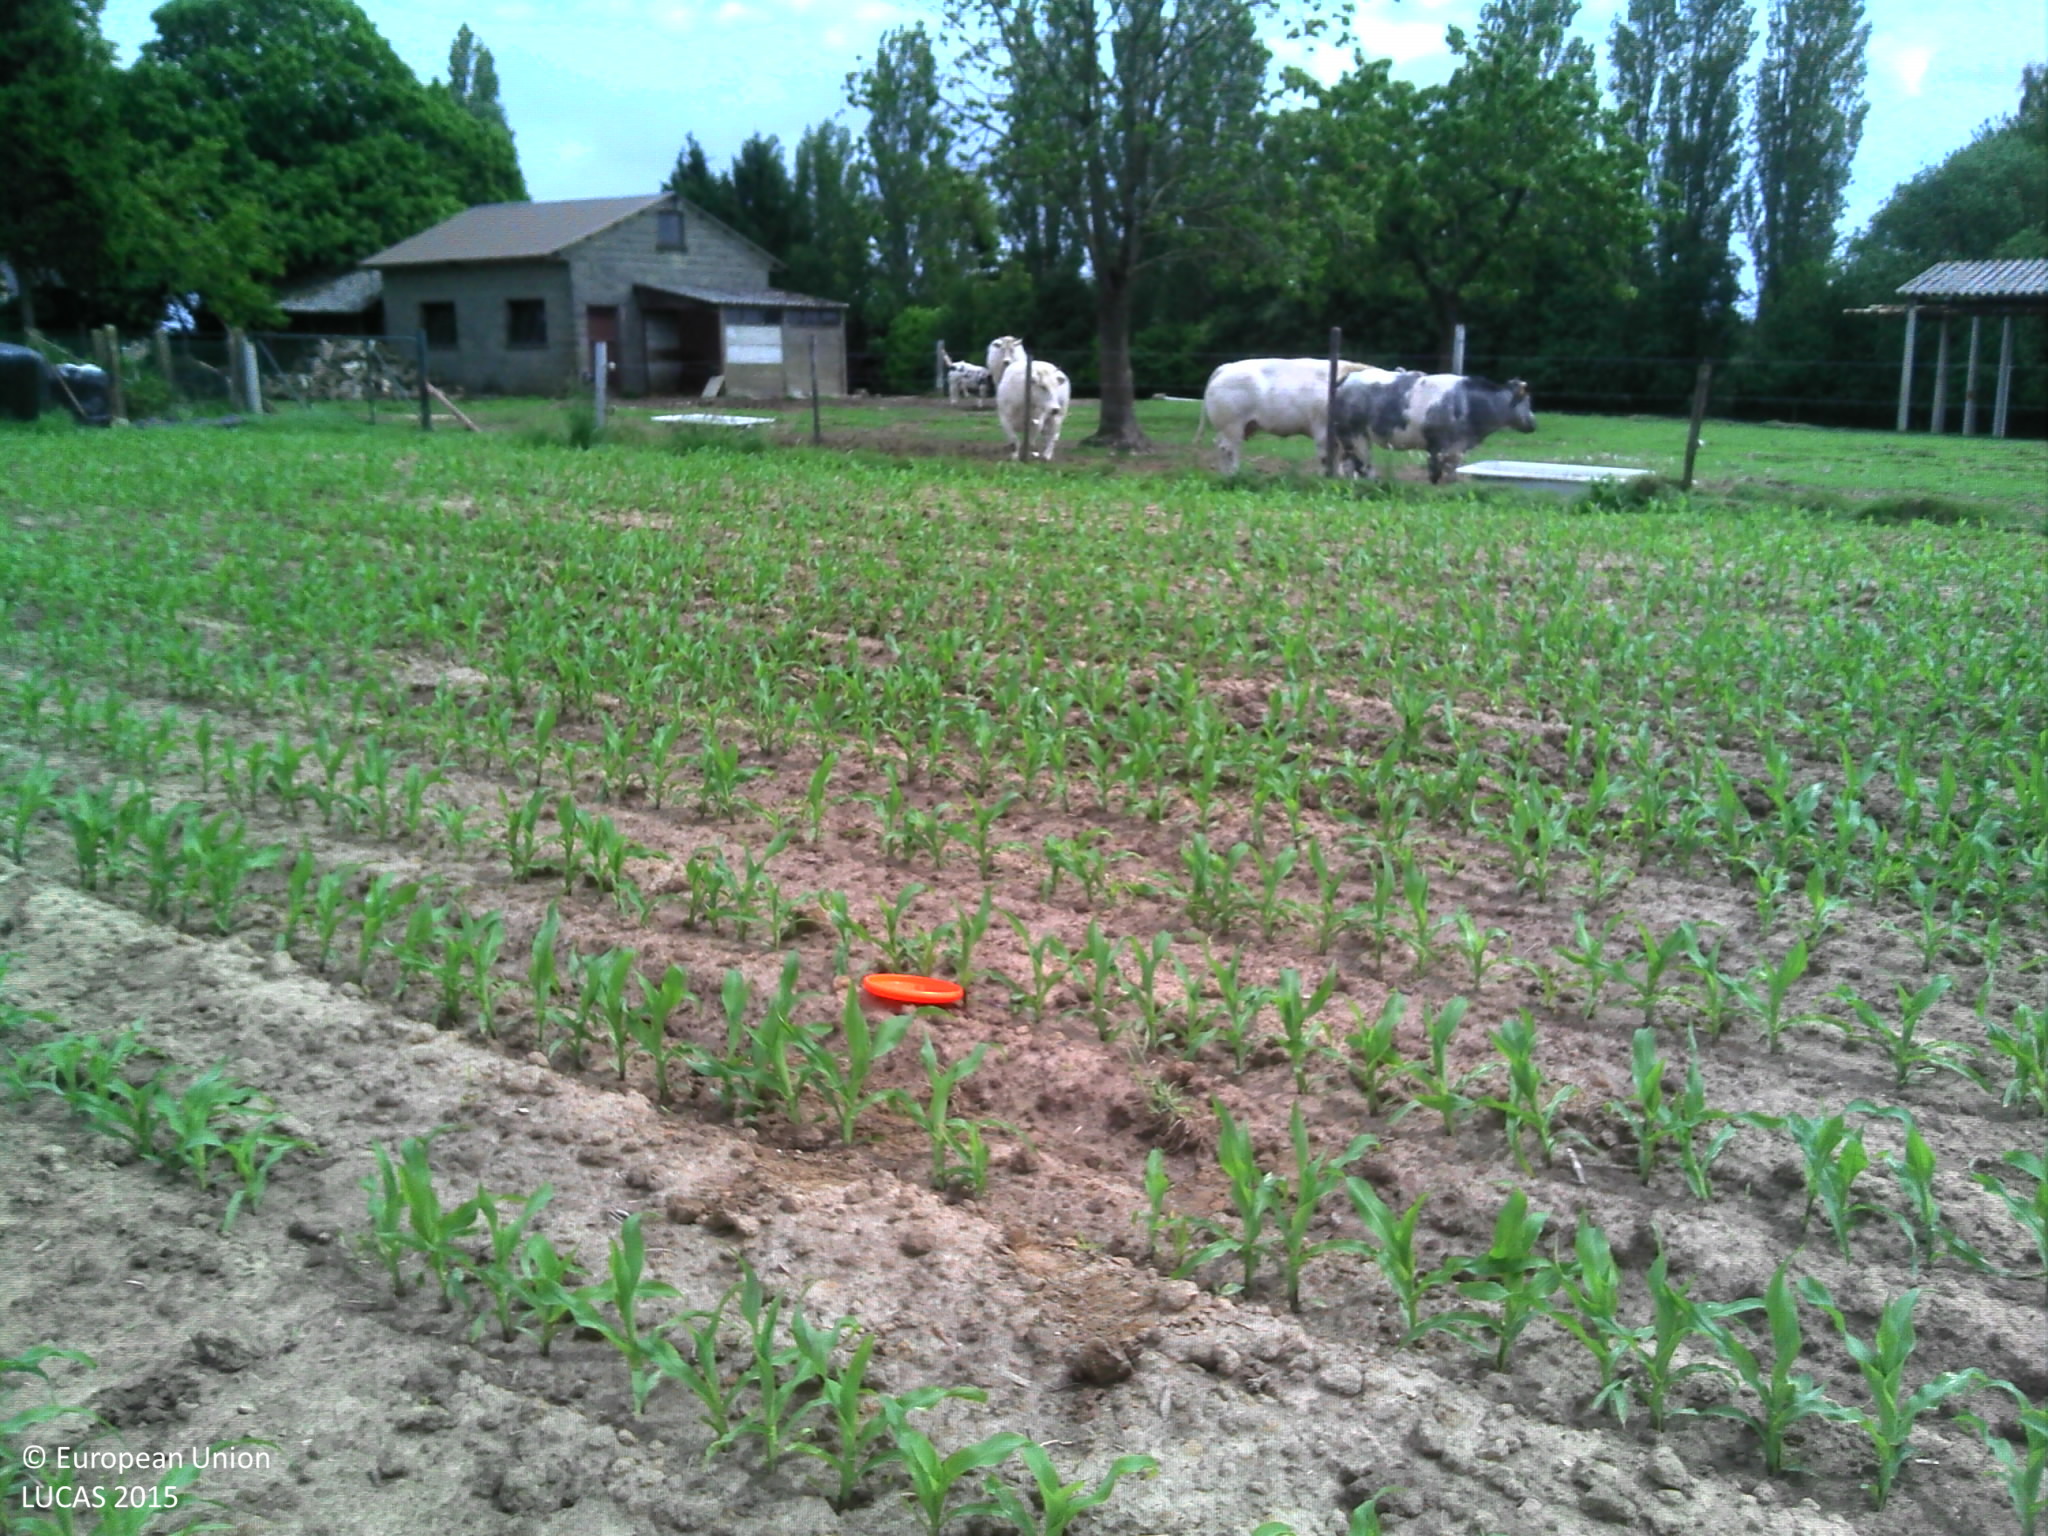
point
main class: Cropland
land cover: Maize
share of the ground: 25 - 50 %
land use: Agriculture (excluding fallow land and kitchen gardens)
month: June
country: BE
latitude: 50.8757
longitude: 4.0396
